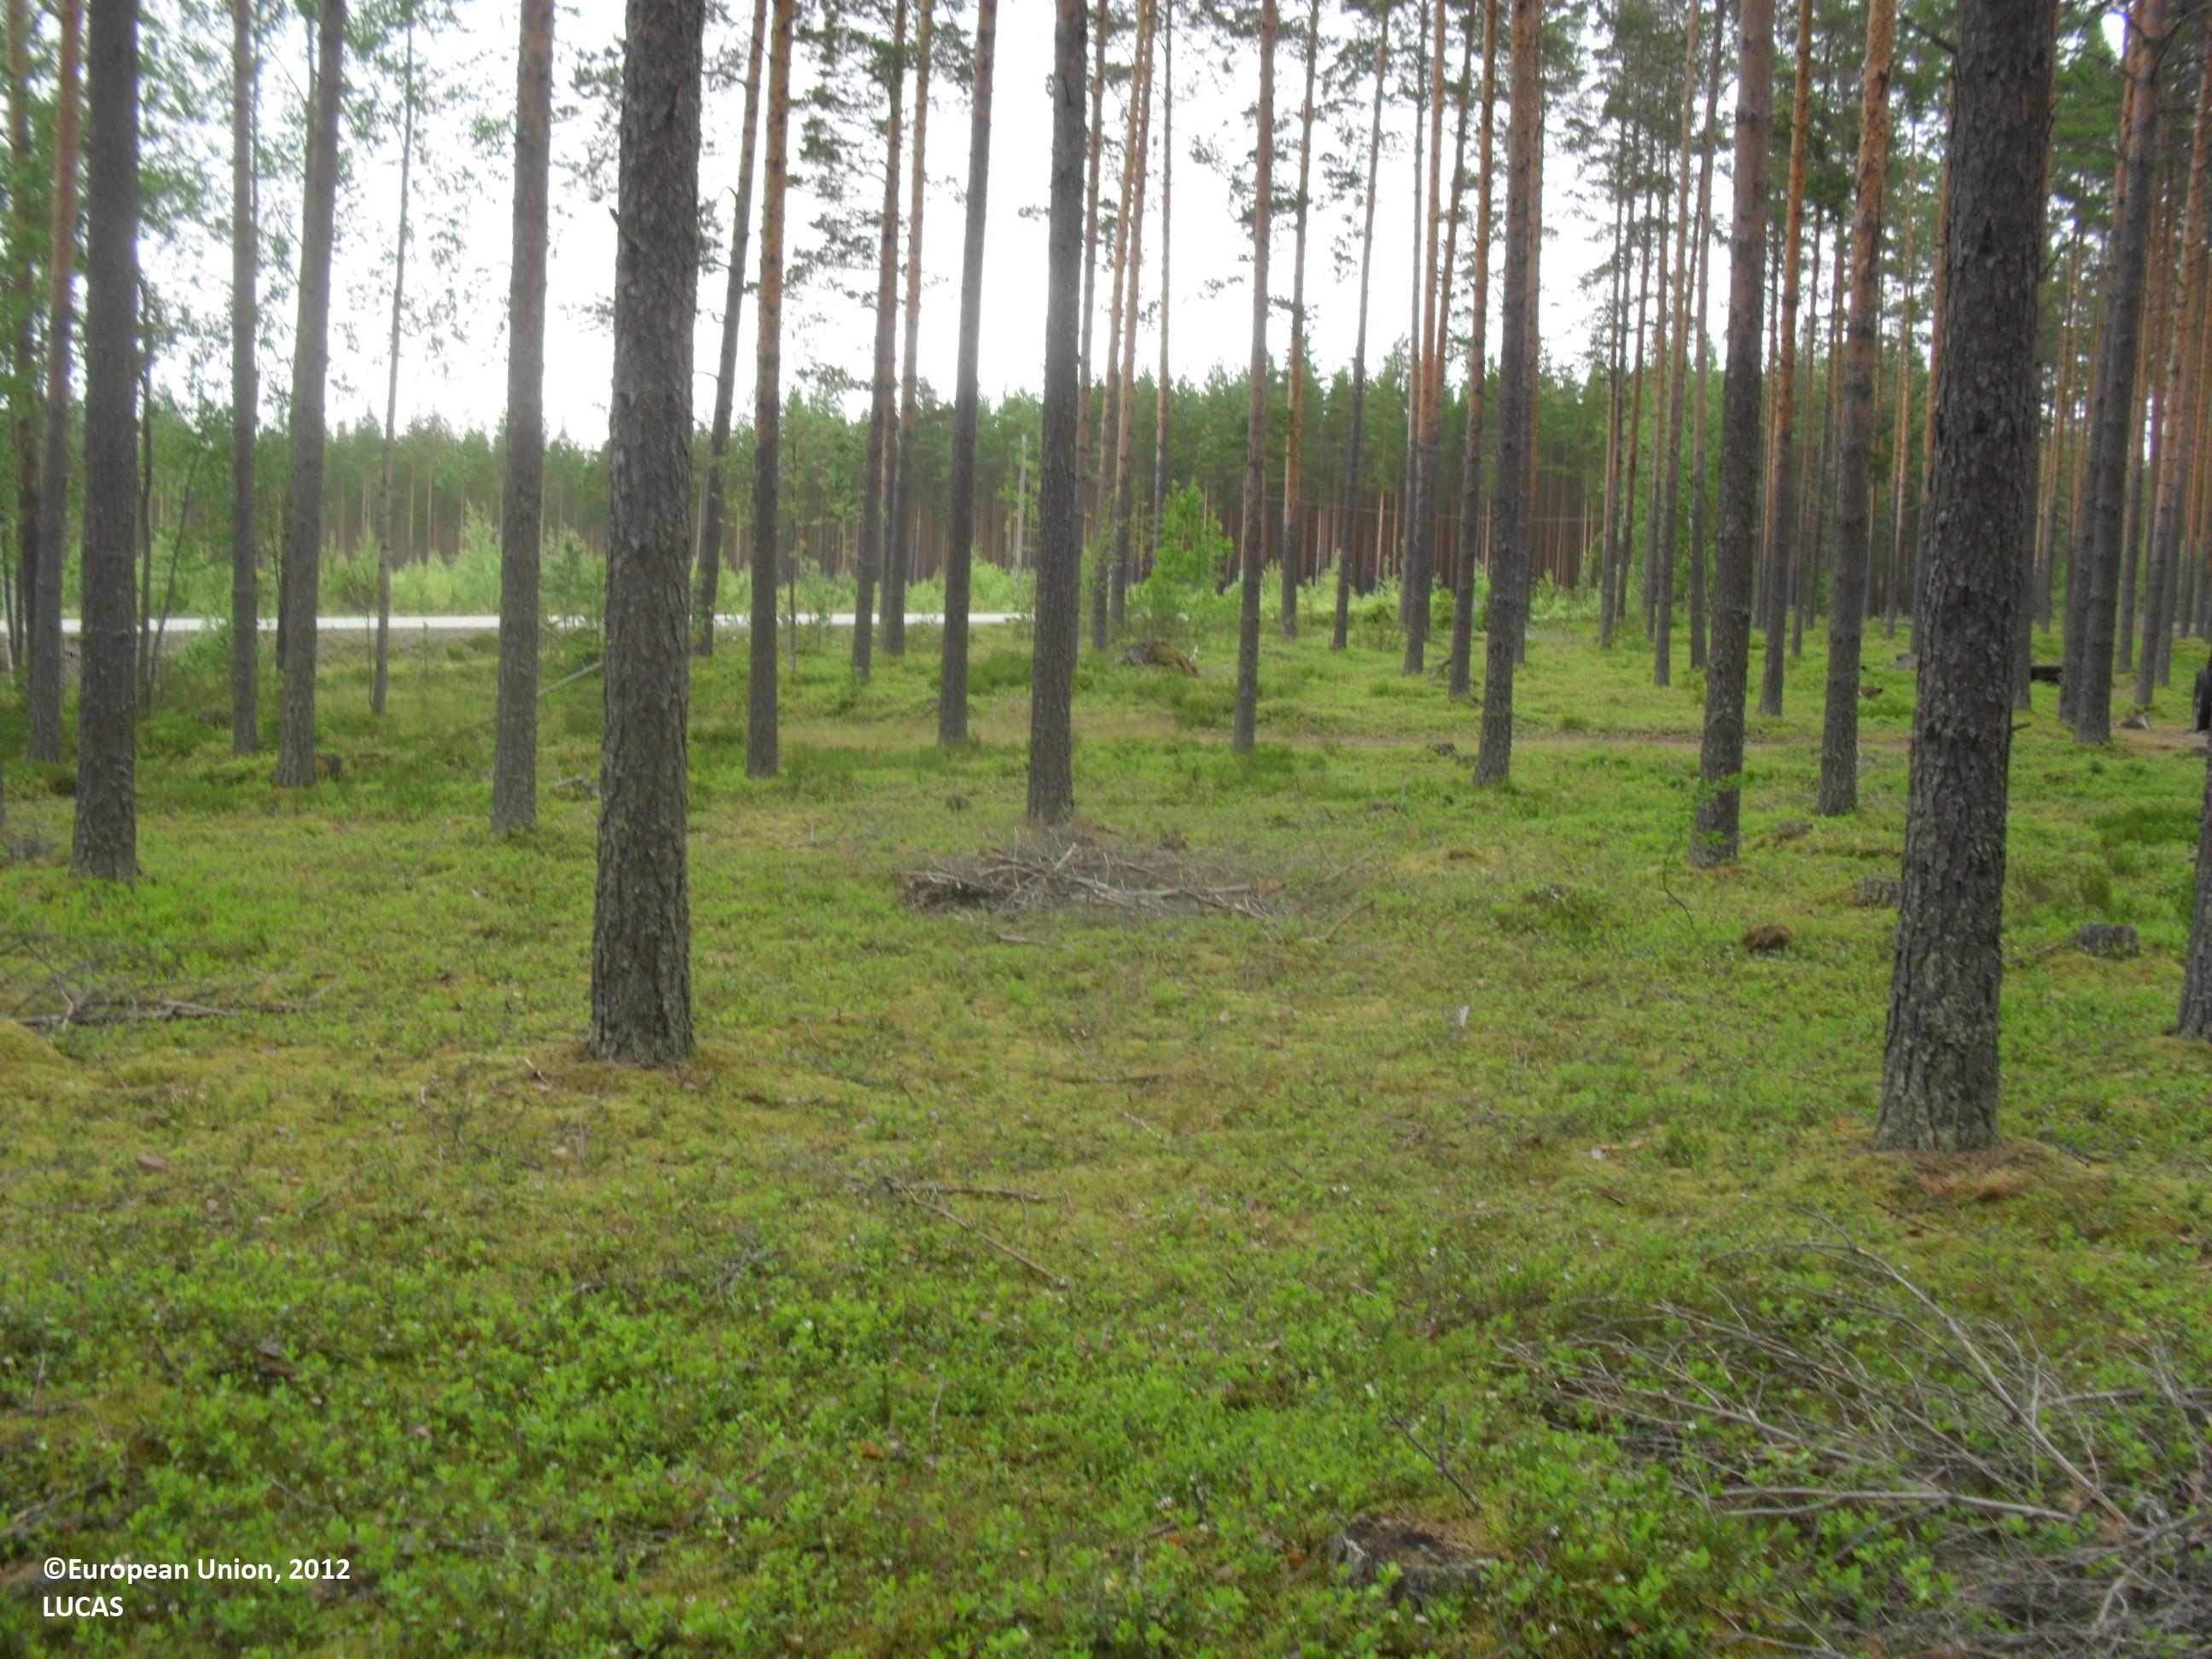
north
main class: Woodland
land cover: Pine dominated coniferous woodland
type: boreal forest
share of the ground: 25 - 50 %
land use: Forestry
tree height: > 5 m
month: June
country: FI
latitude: 62.9521
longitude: 23.5305
